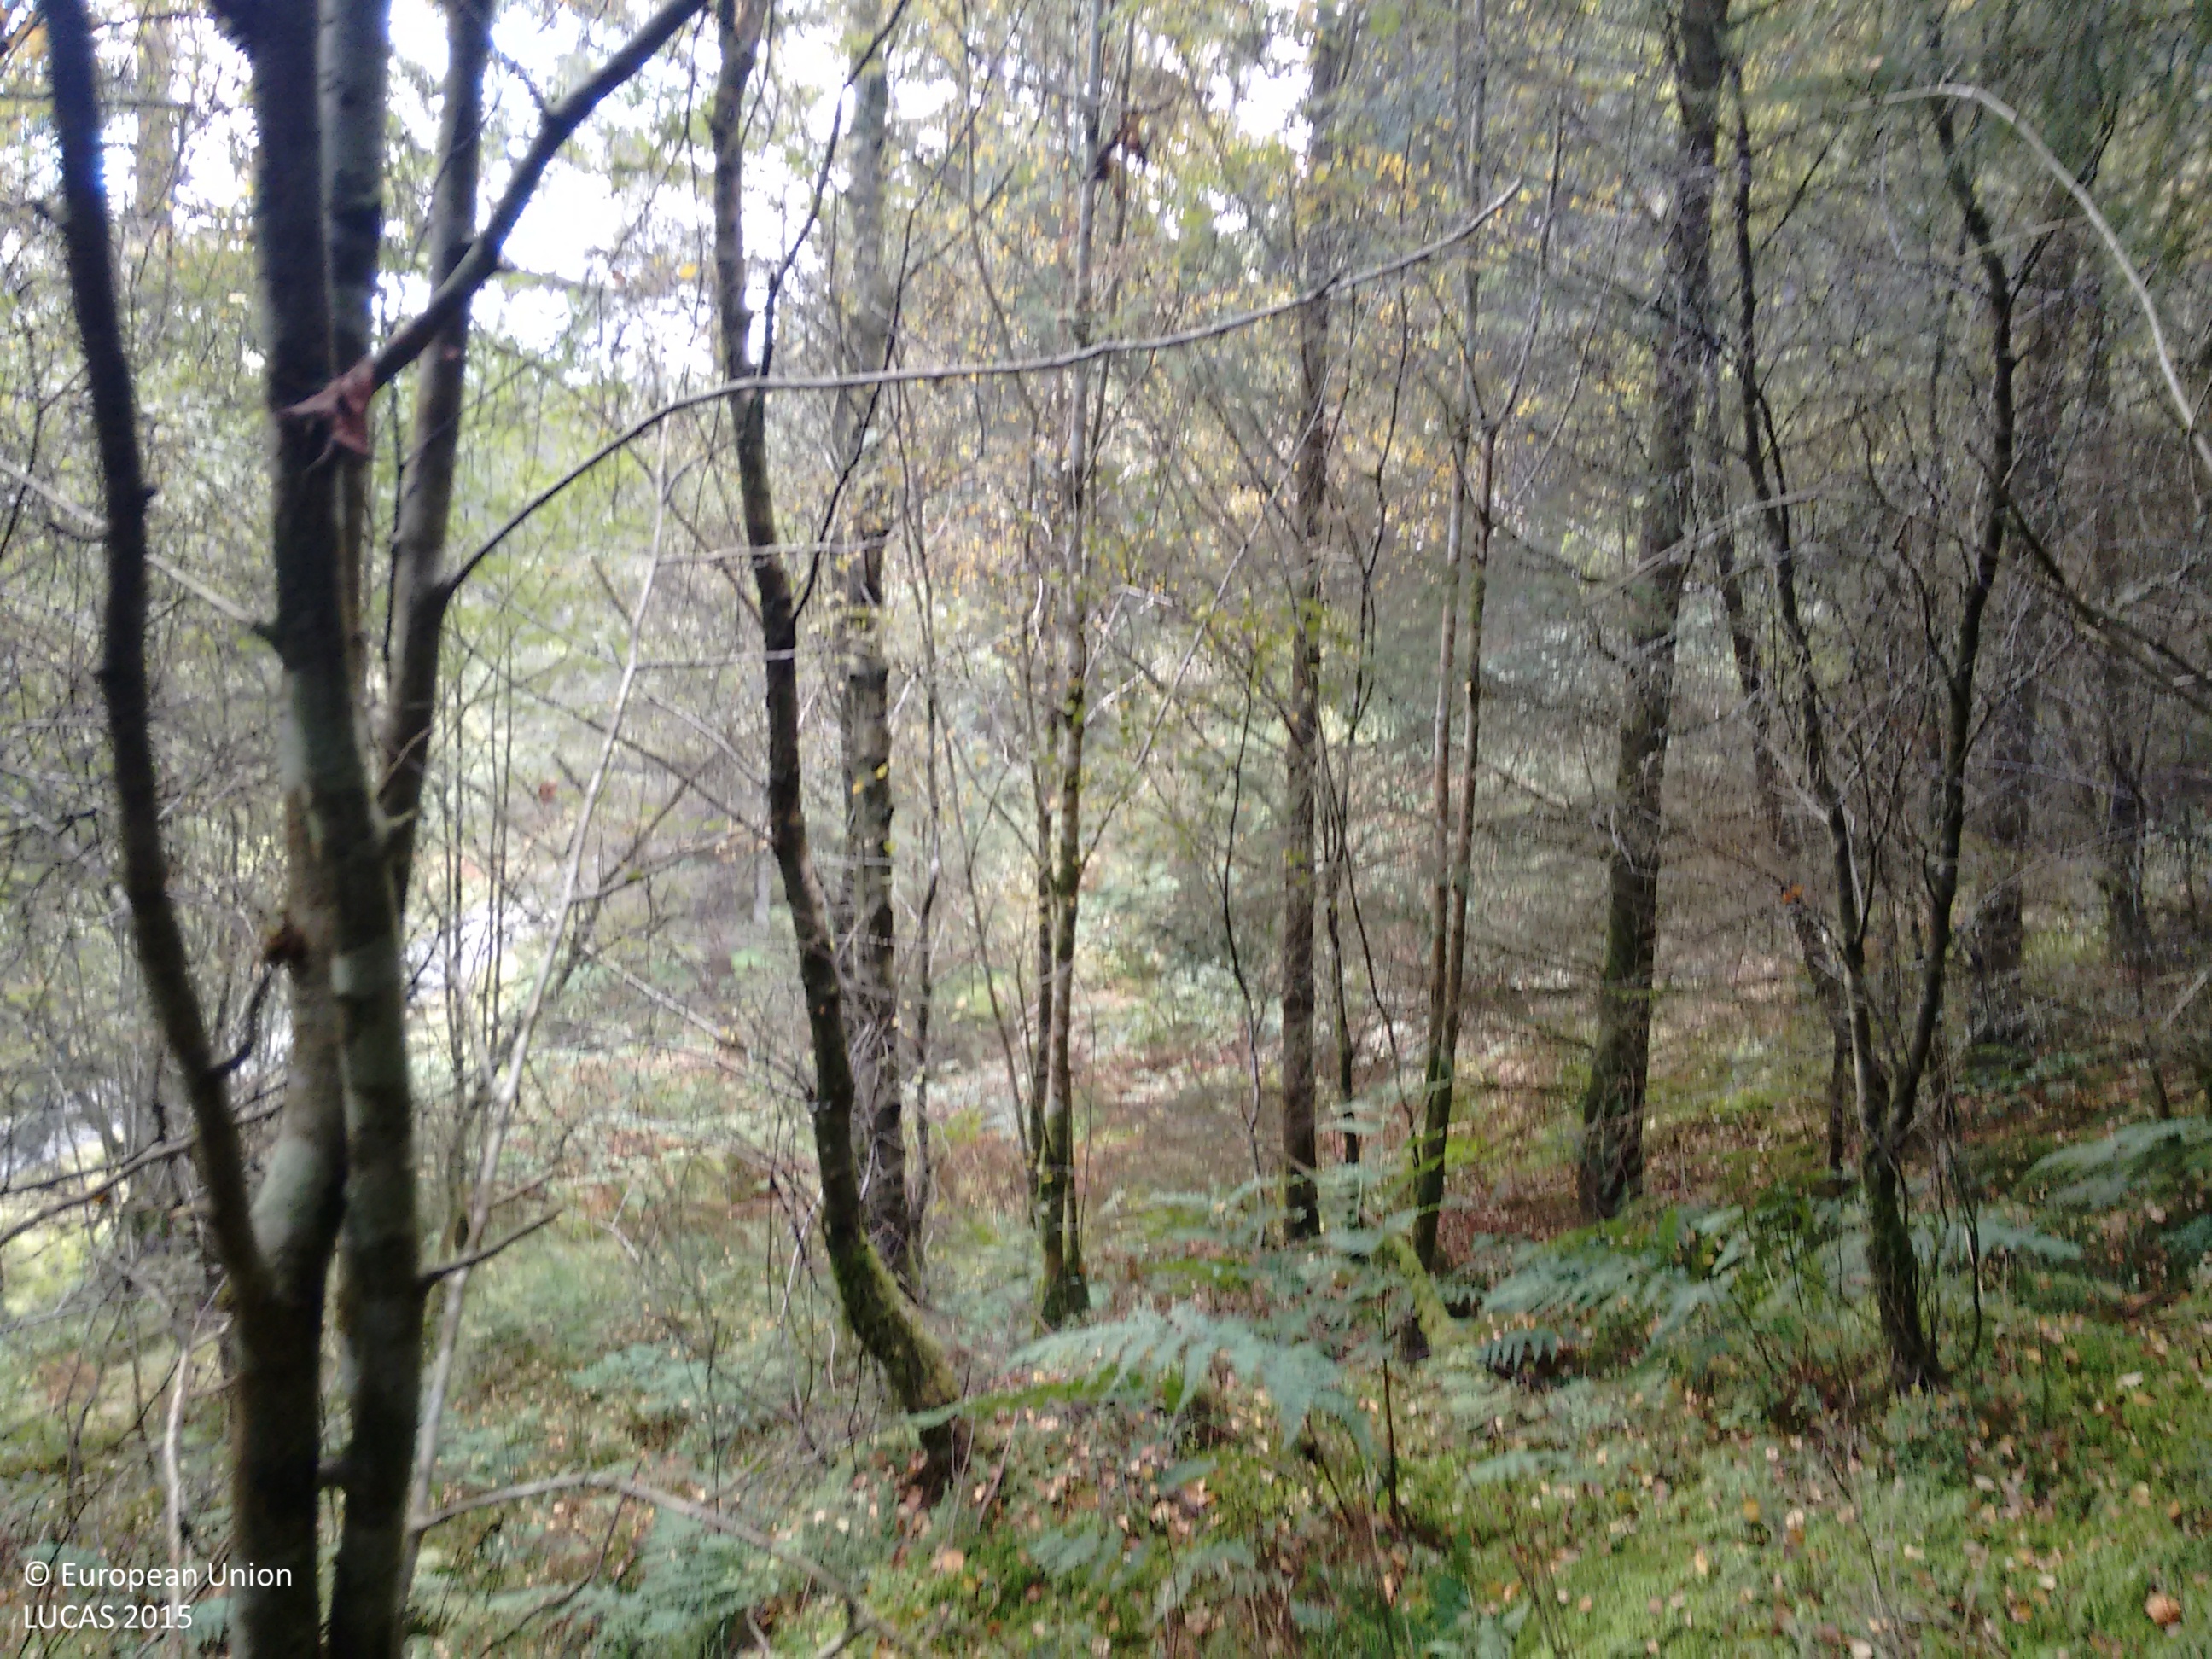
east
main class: Woodland
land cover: Pine dominated coniferous woodland
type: exotic forest
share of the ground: > 75 %
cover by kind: coniferous forest trees 100 %
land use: Forestry
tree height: > 5 m
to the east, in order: Pine dominated coniferous woodland; Tracks; Pine dominated coniferous woodland; Grass margins; Pine dominated coniferous woodland
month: October
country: GB
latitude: 52.5217
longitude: -3.9020
